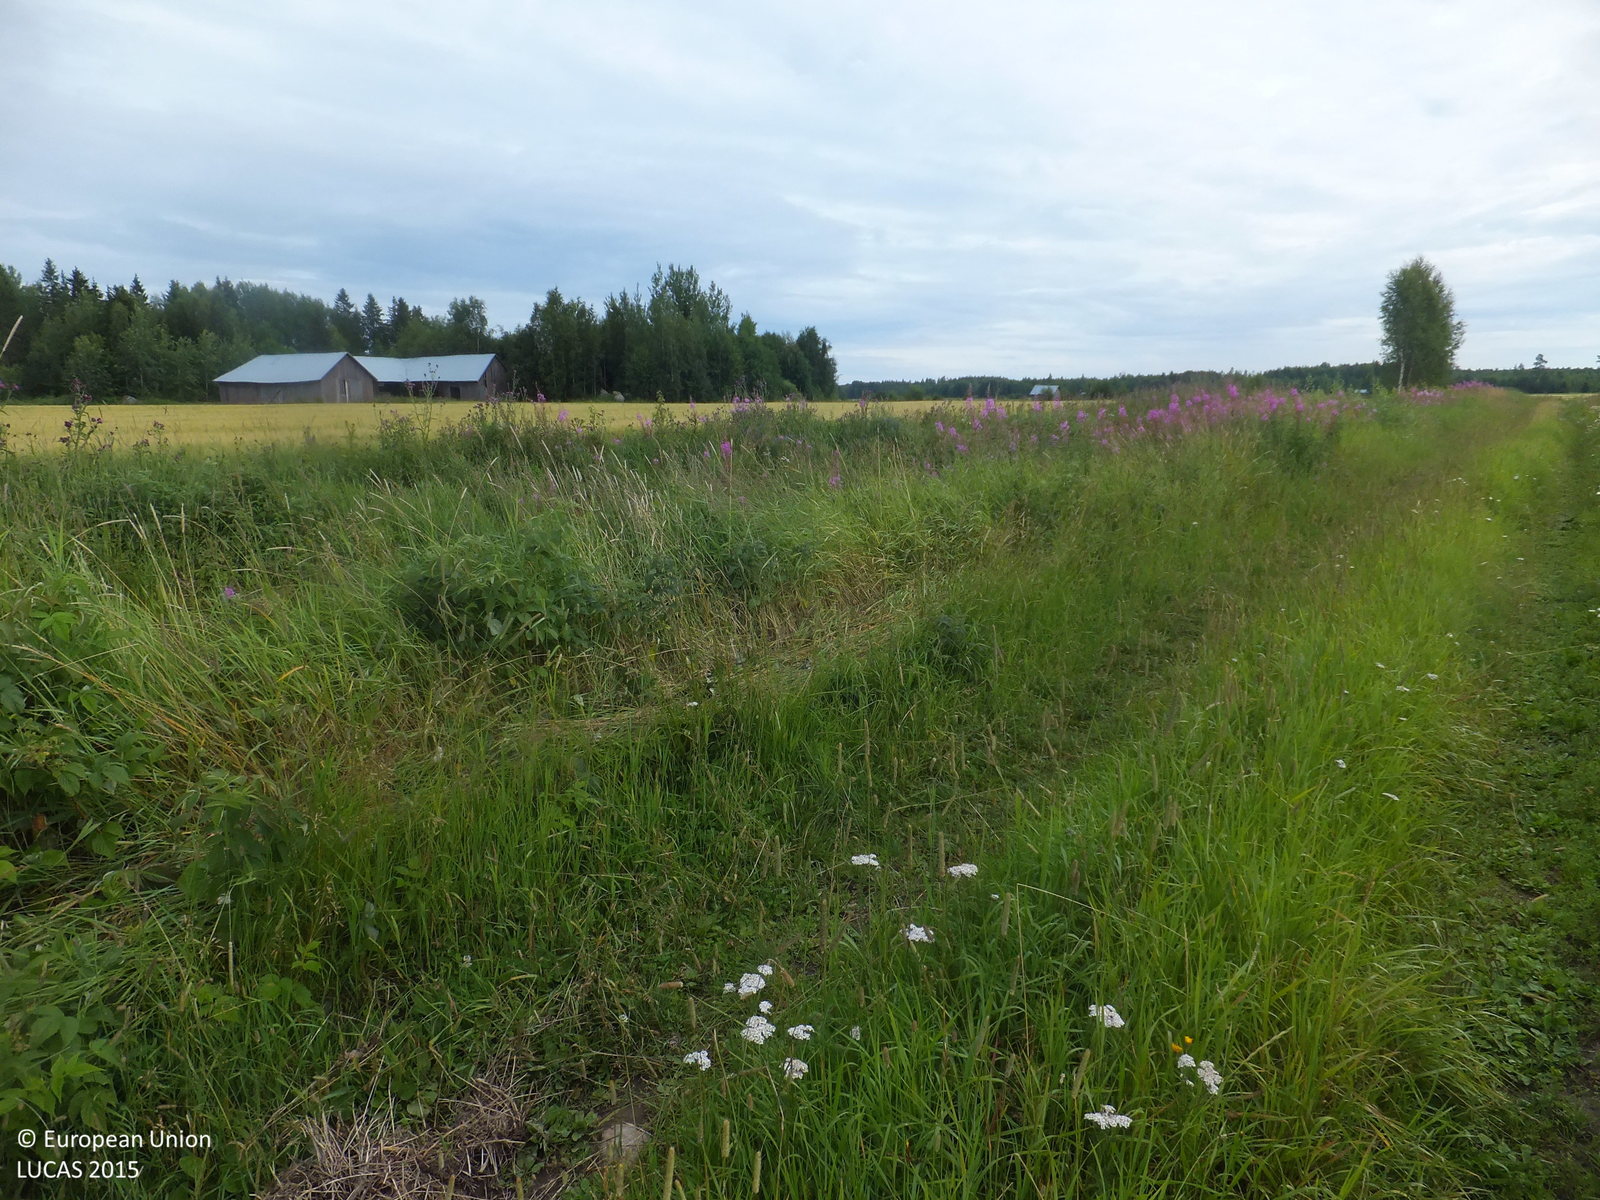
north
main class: Cropland
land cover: Barley
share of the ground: > 75 %
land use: Agriculture (excluding fallow land and kitchen gardens)
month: July
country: FI
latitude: 63.0409
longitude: 22.0466
